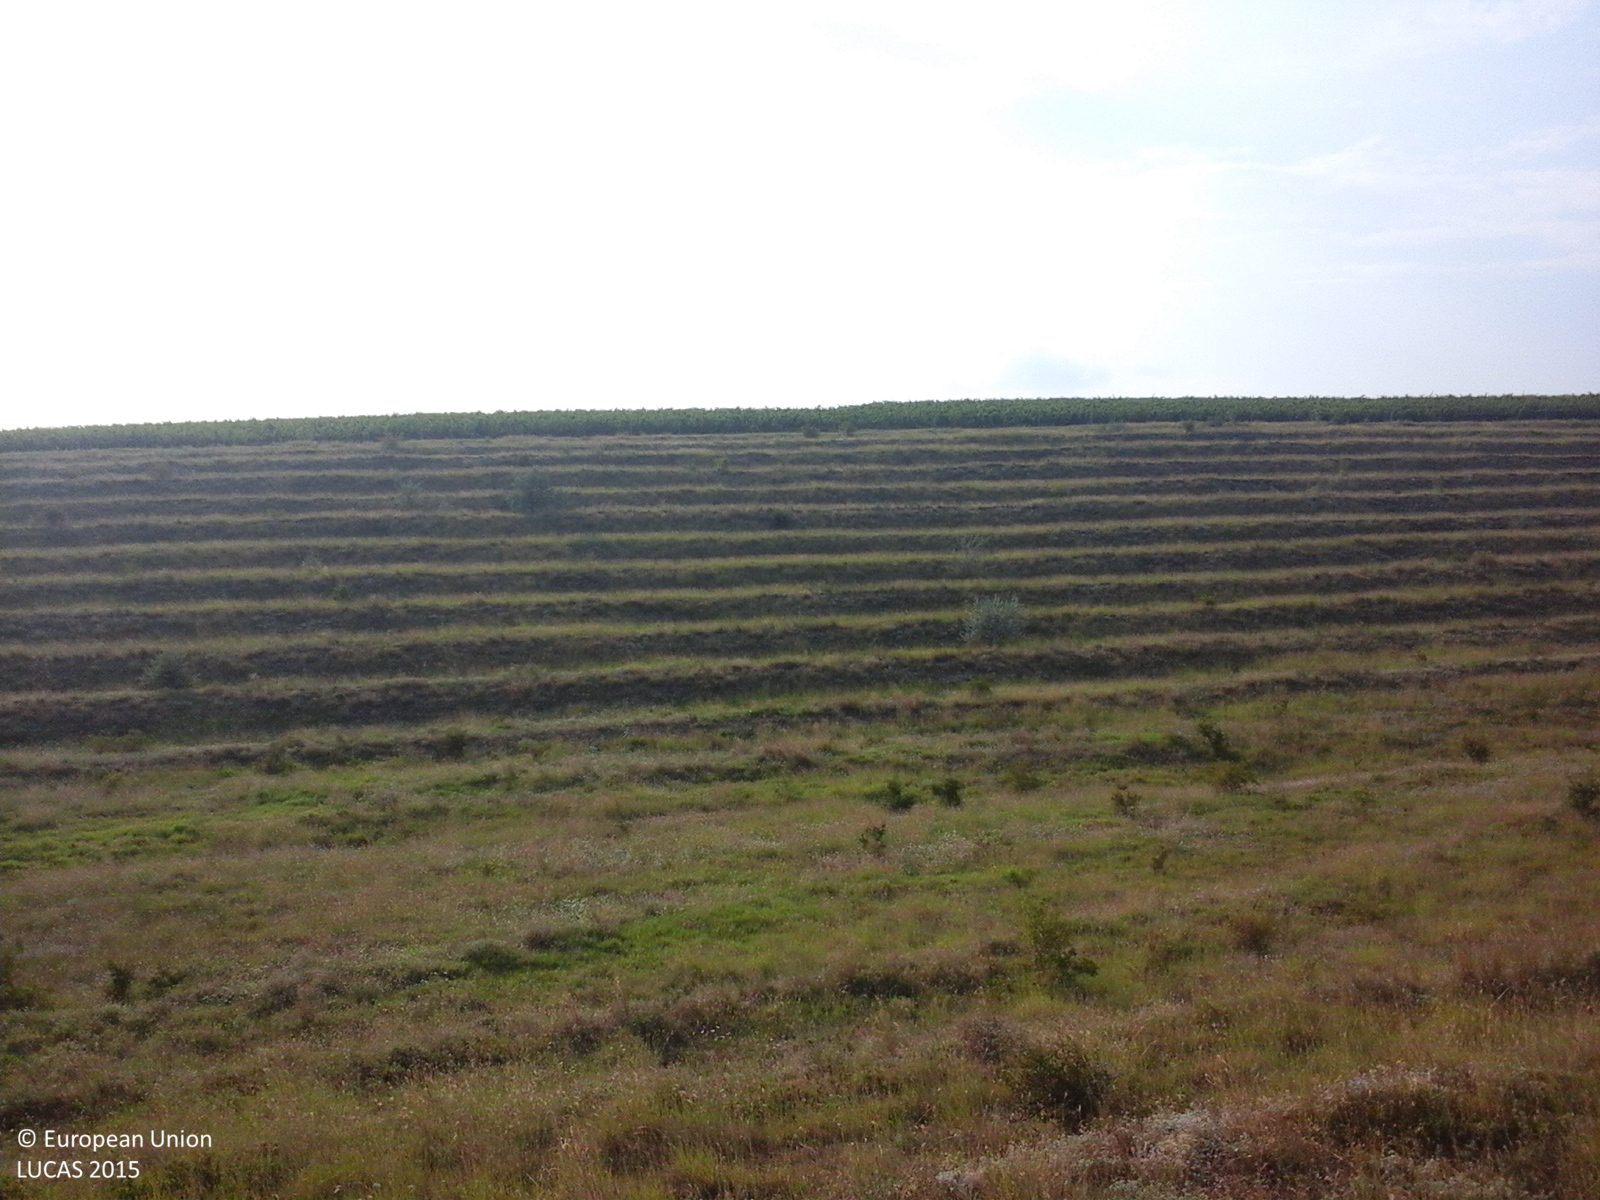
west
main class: Grassland
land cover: Grassland without tree/shrub cover
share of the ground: > 75 %
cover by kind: herbaceous plants 100 %
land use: Agriculture (excluding fallow land and kitchen gardens)
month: July
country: RO
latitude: 45.1298
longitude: 28.2663
